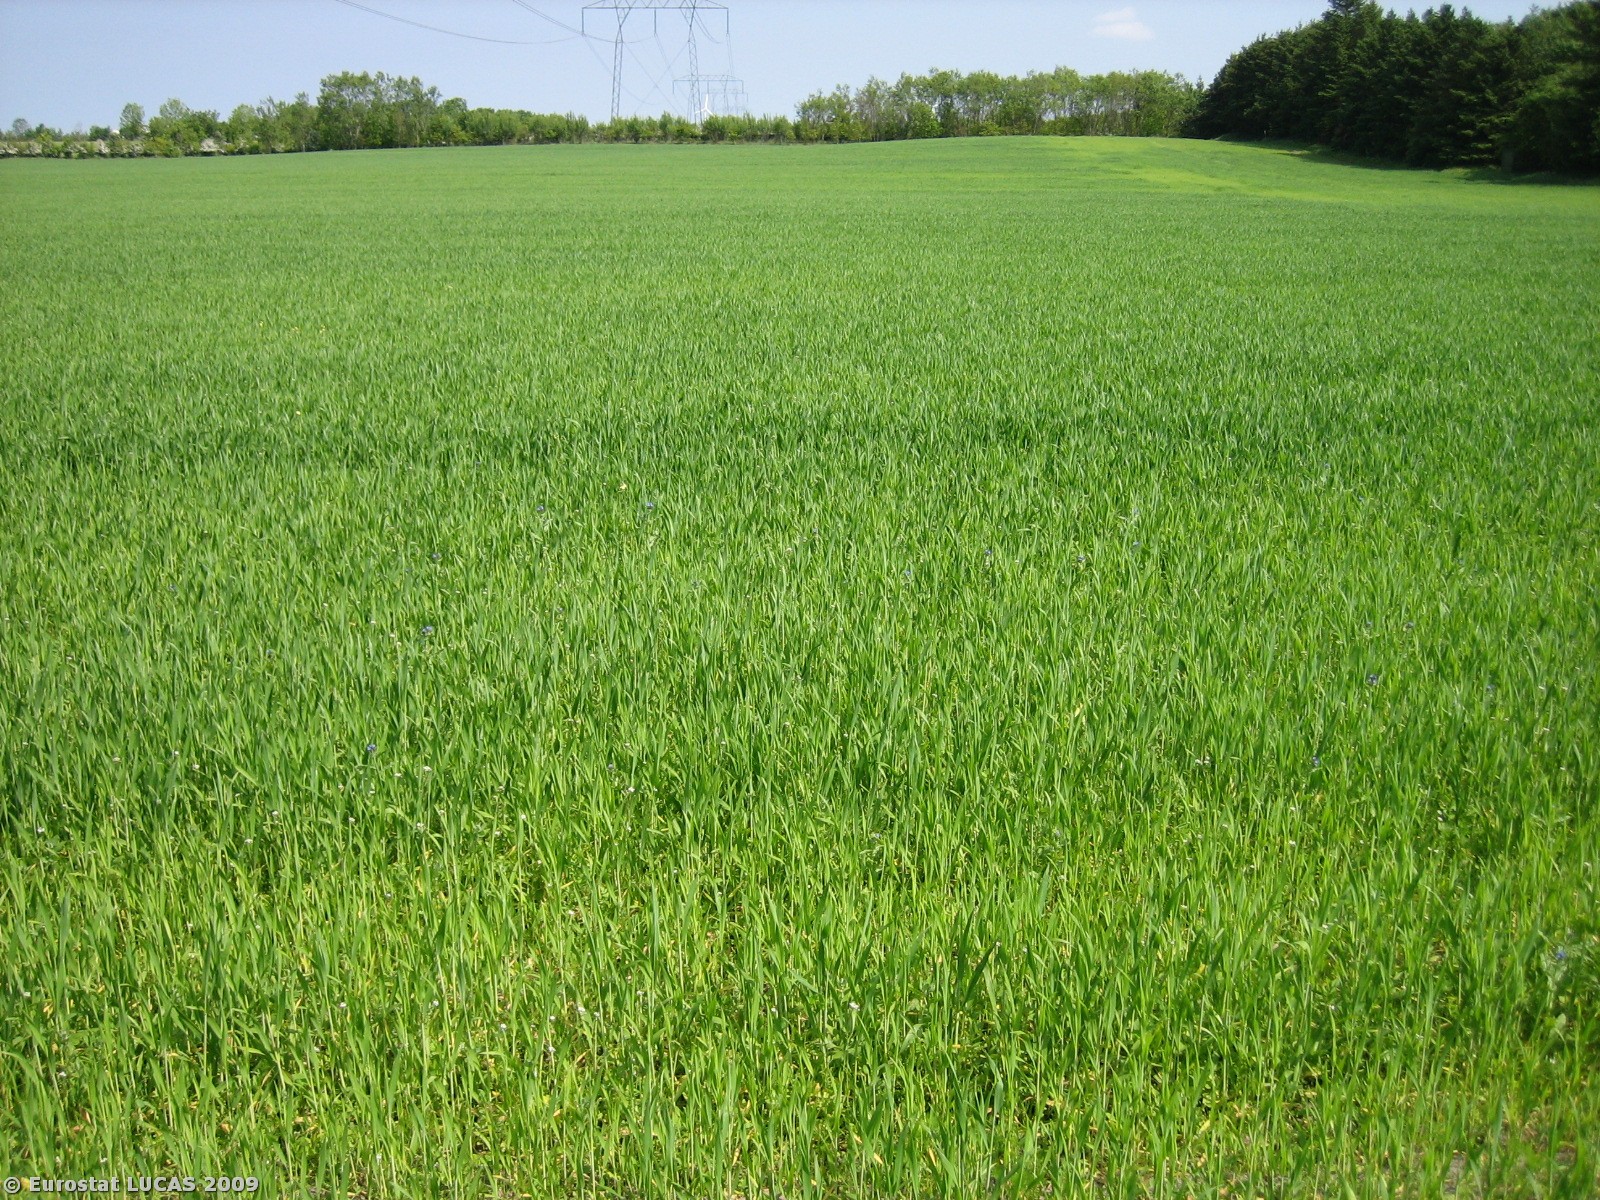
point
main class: Cropland
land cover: Barley
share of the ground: > 75 %
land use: Agriculture (excluding fallow land and kitchen gardens)
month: May
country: DK
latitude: 56.1138
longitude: 9.2771
